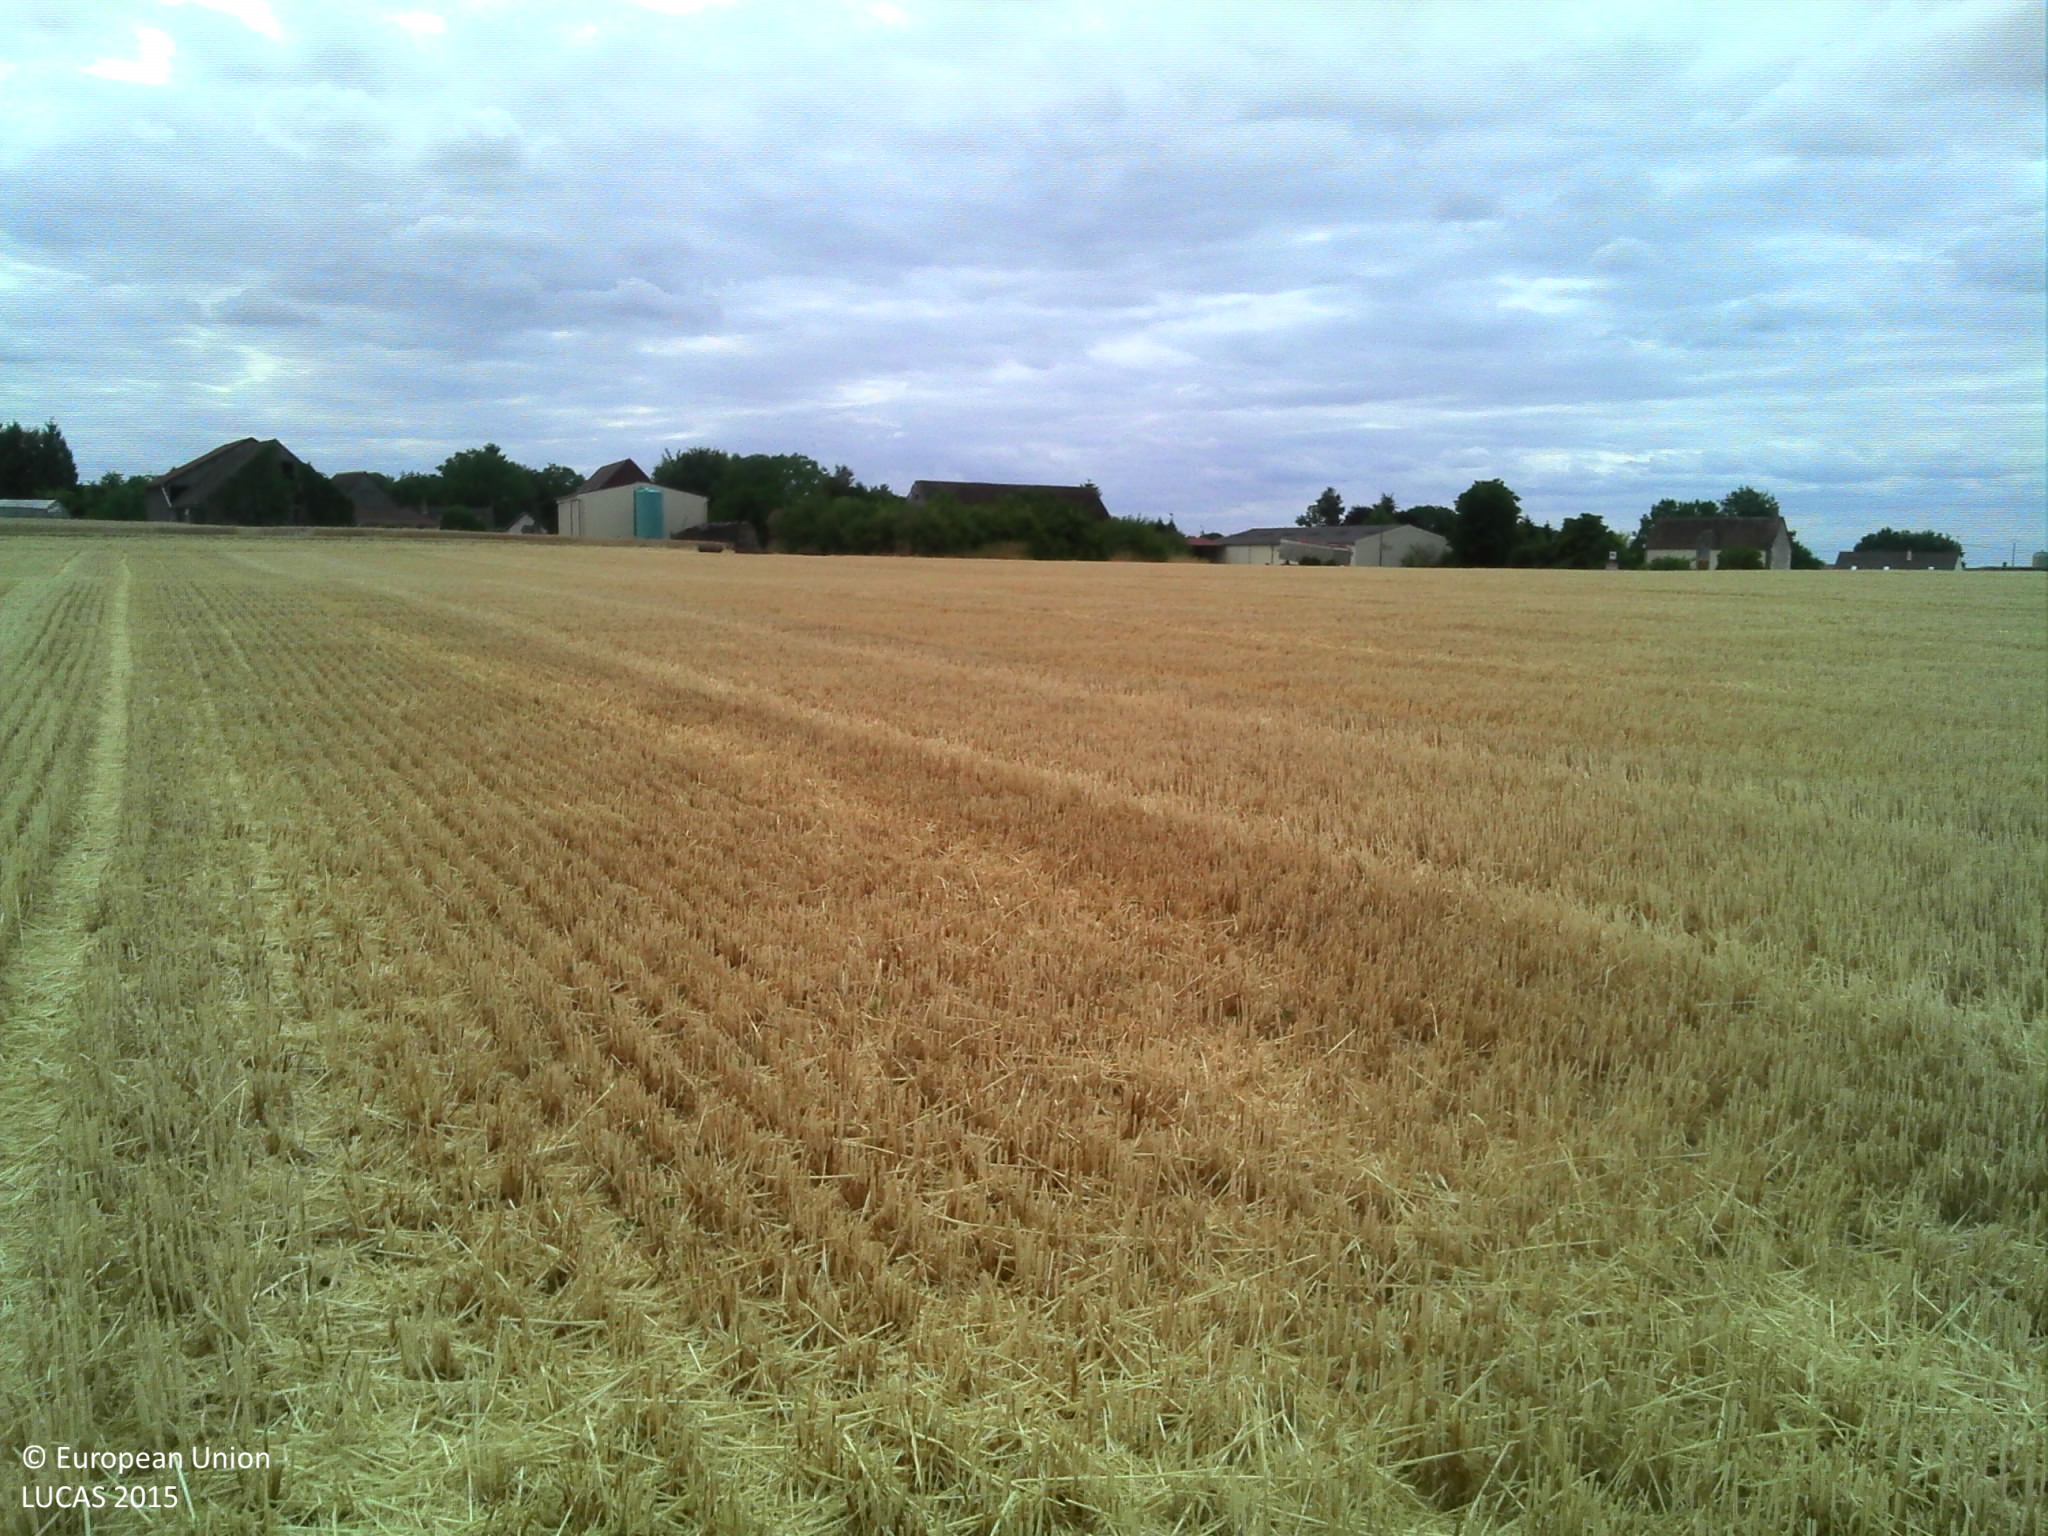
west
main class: Cropland
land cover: Common wheat
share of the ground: > 75 %
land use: Agriculture (excluding fallow land and kitchen gardens)
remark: Harvested field
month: July
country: FR
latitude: 48.3667
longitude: 3.3660
